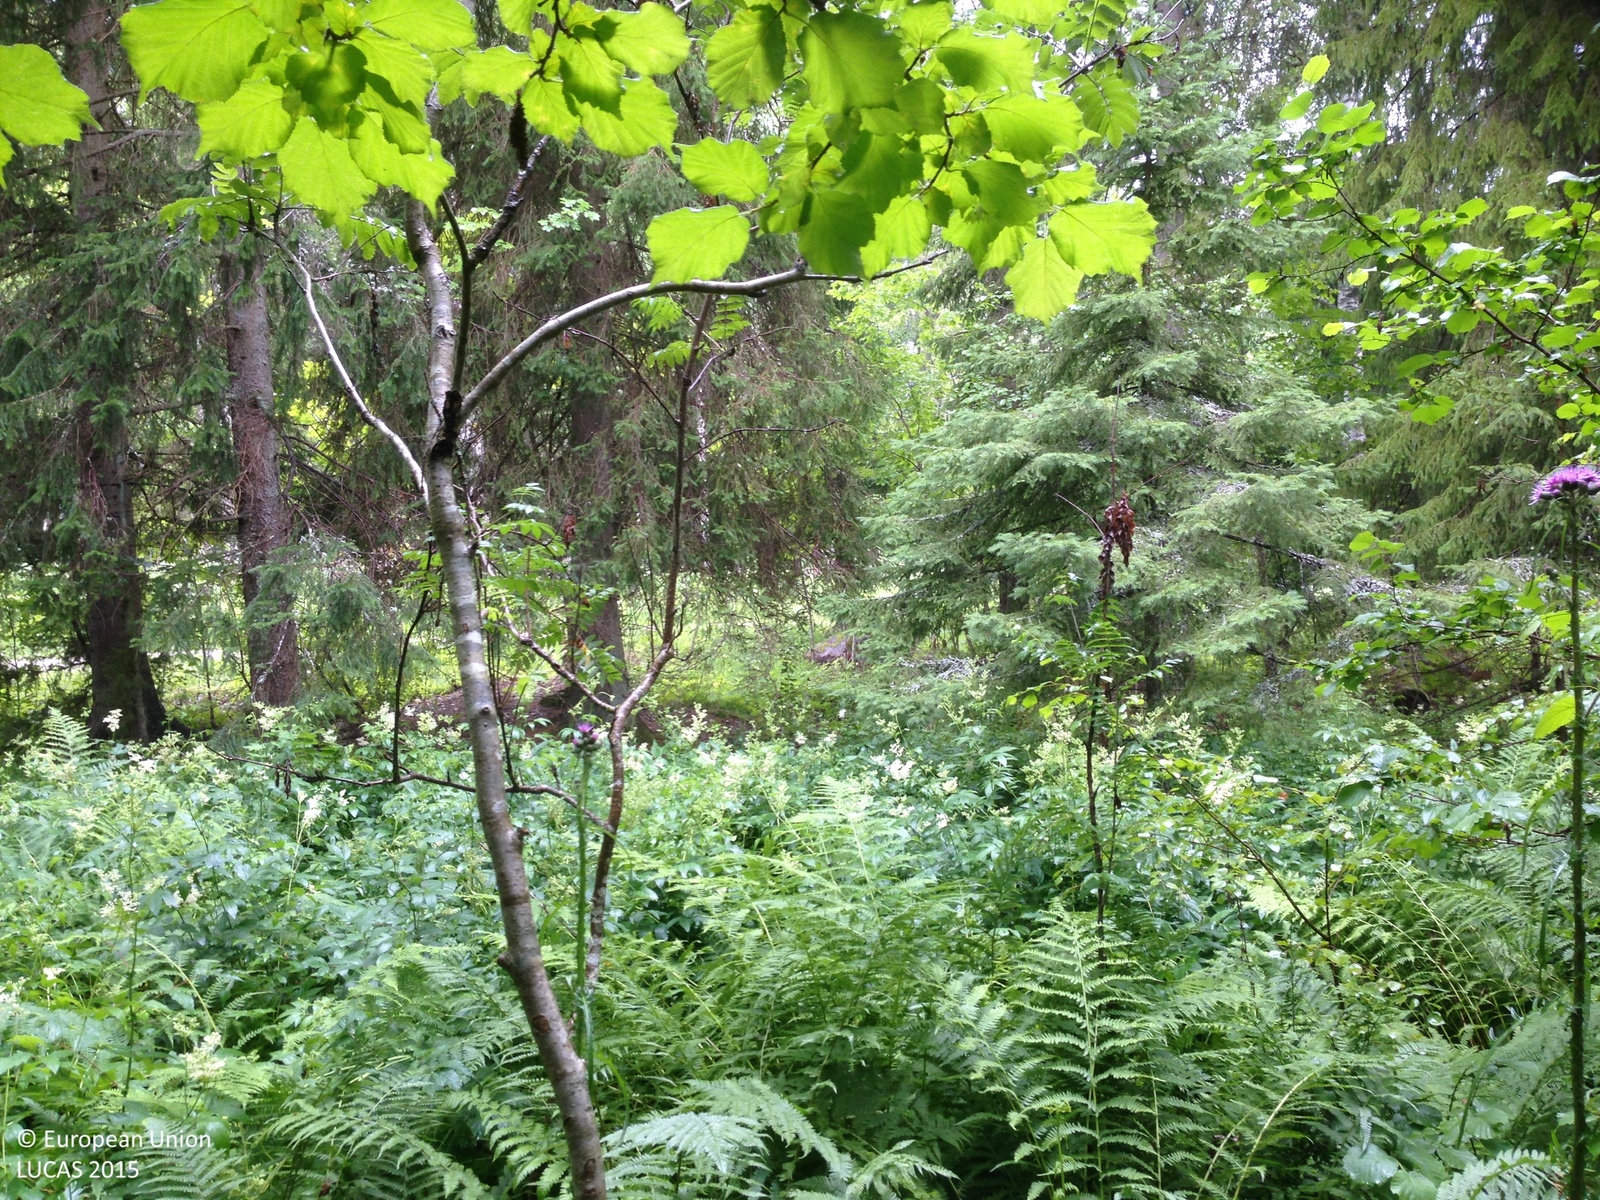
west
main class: Woodland
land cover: Spruce dominated mixed woodland
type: boreal forest
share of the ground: 50 - 75 %
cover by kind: coniferous forest trees 45 %, herbaceous plants 40 %, broadleaved forest trees 15 %
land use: Forestry
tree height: > 5 m
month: July
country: SE
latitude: 59.9377
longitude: 18.5708
